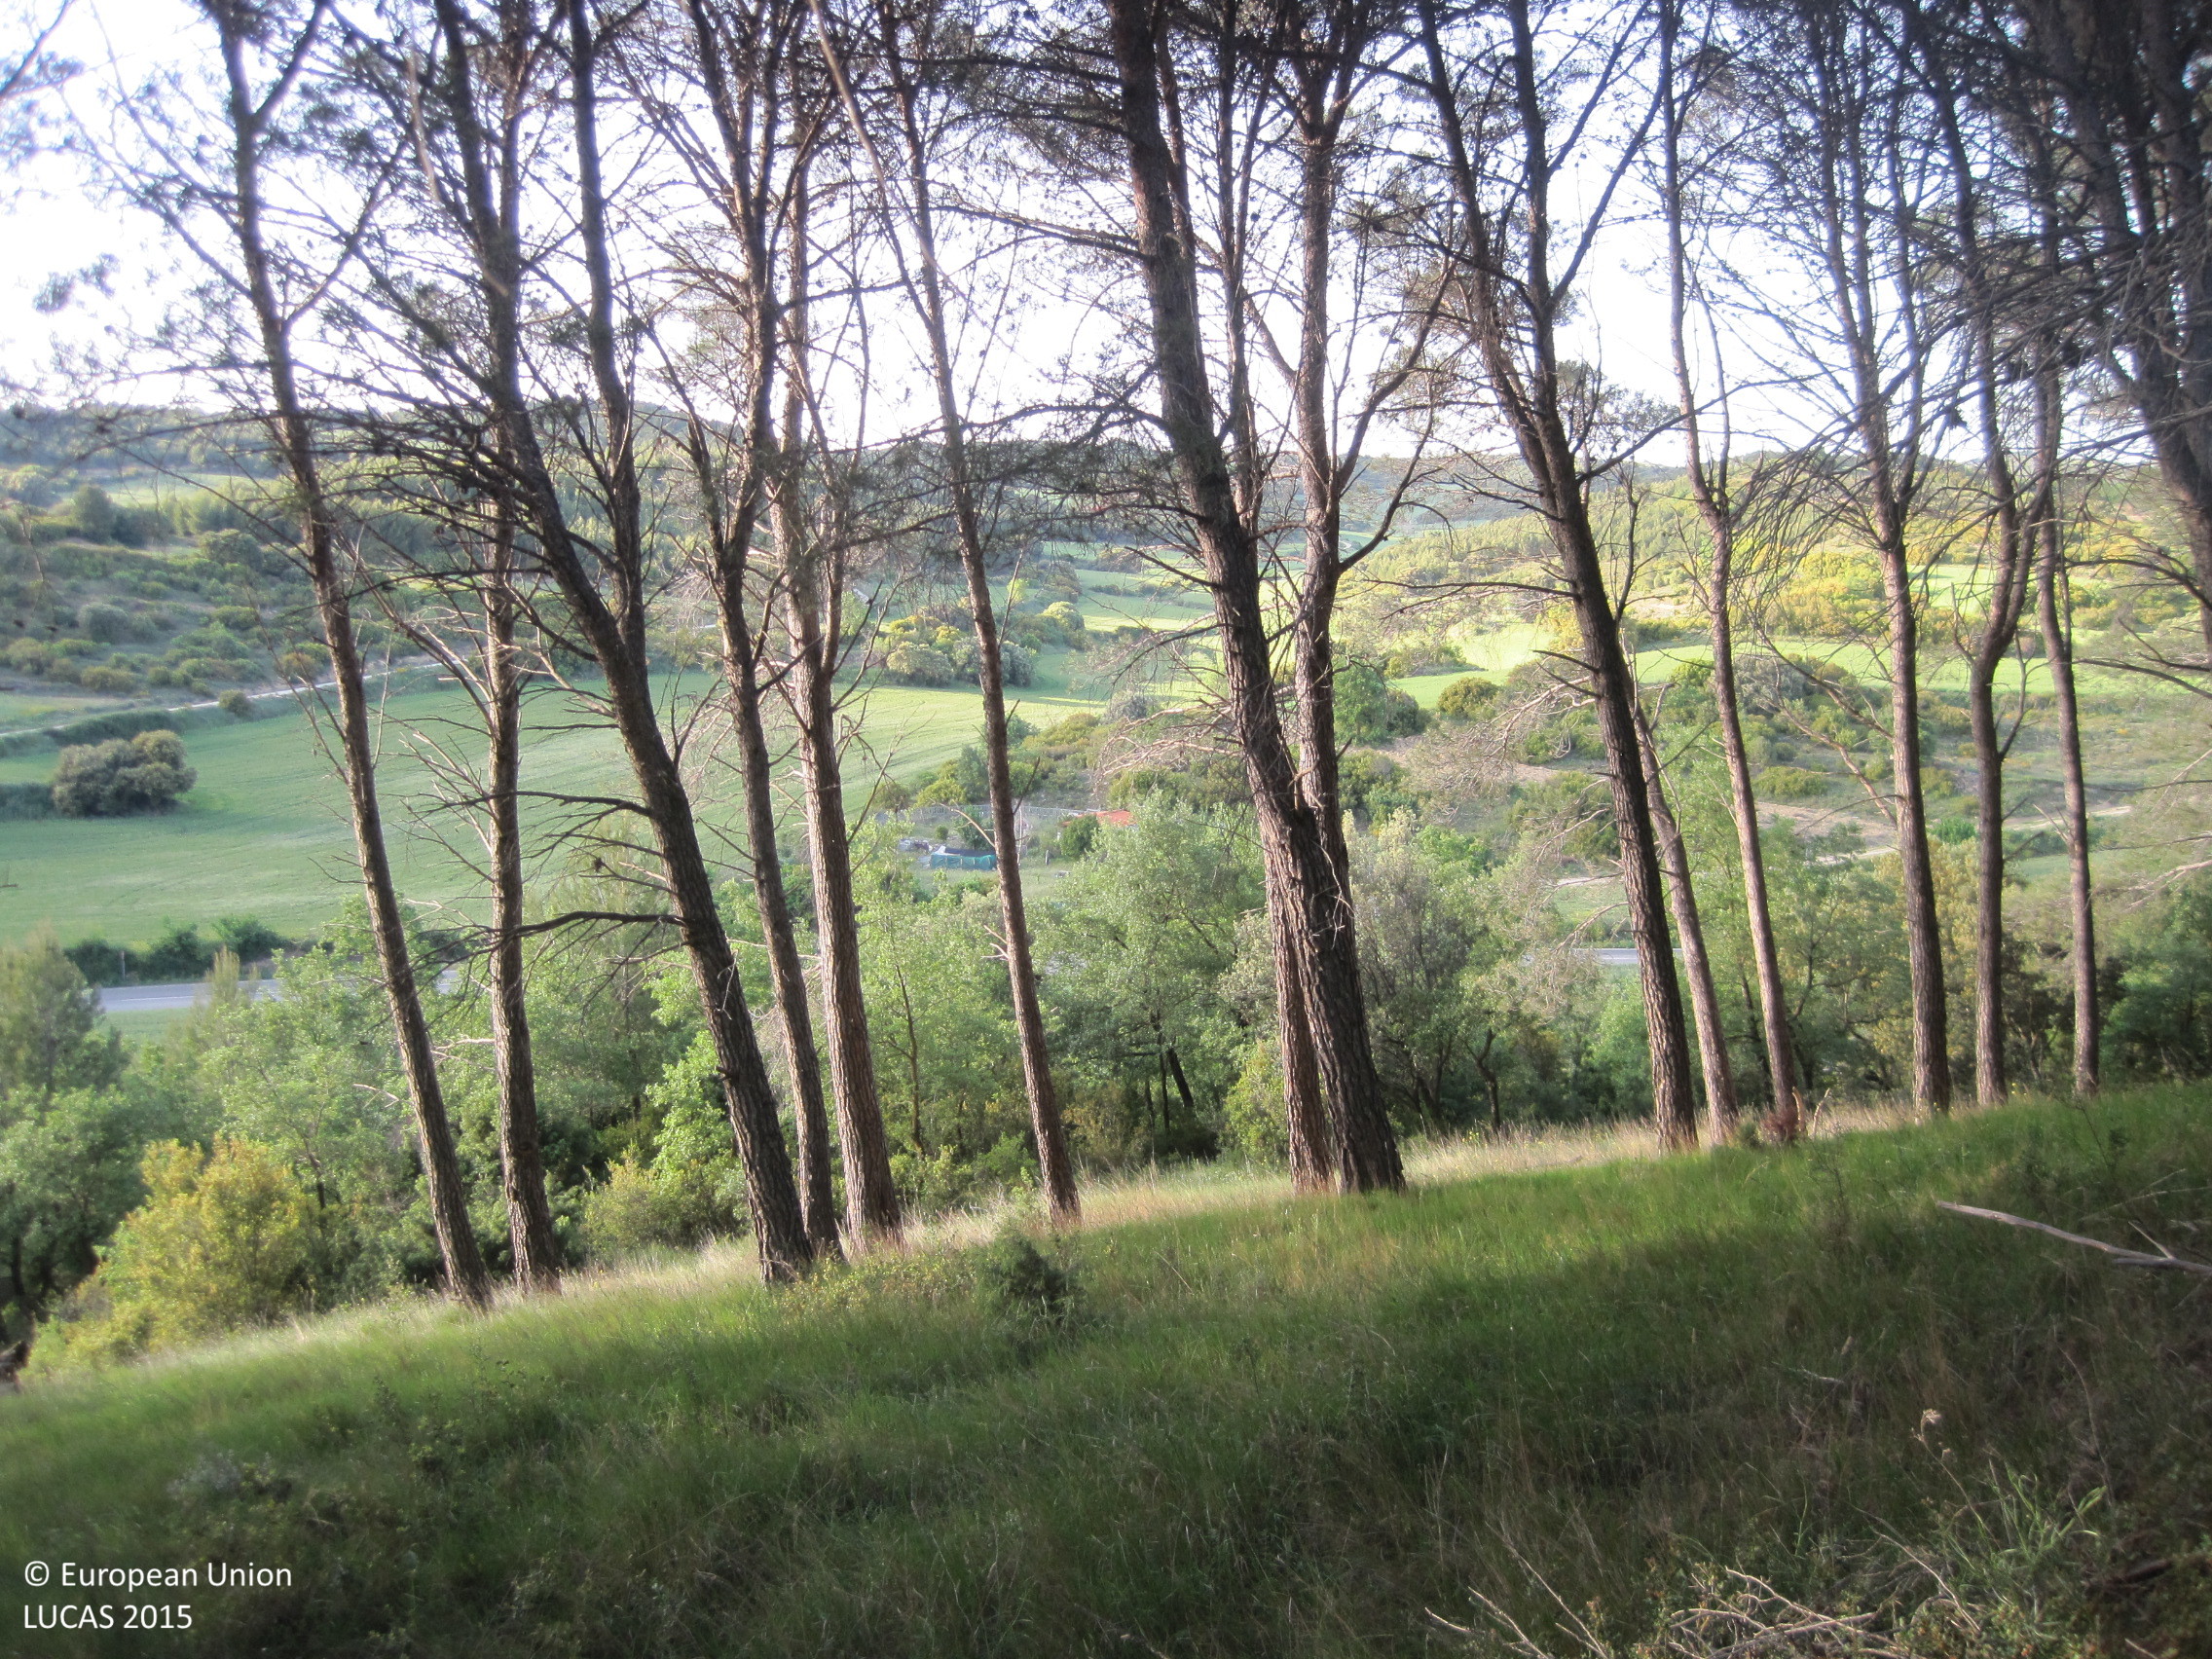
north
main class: Woodland
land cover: Pine dominated coniferous woodland
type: coniferous forest of the mediterranean region
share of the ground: > 75 %
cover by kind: coniferous forest trees 85 %, herbaceous plants 15 %
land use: Forestry
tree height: > 5 m
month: May
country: ES
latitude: 42.6082
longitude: -1.7279
